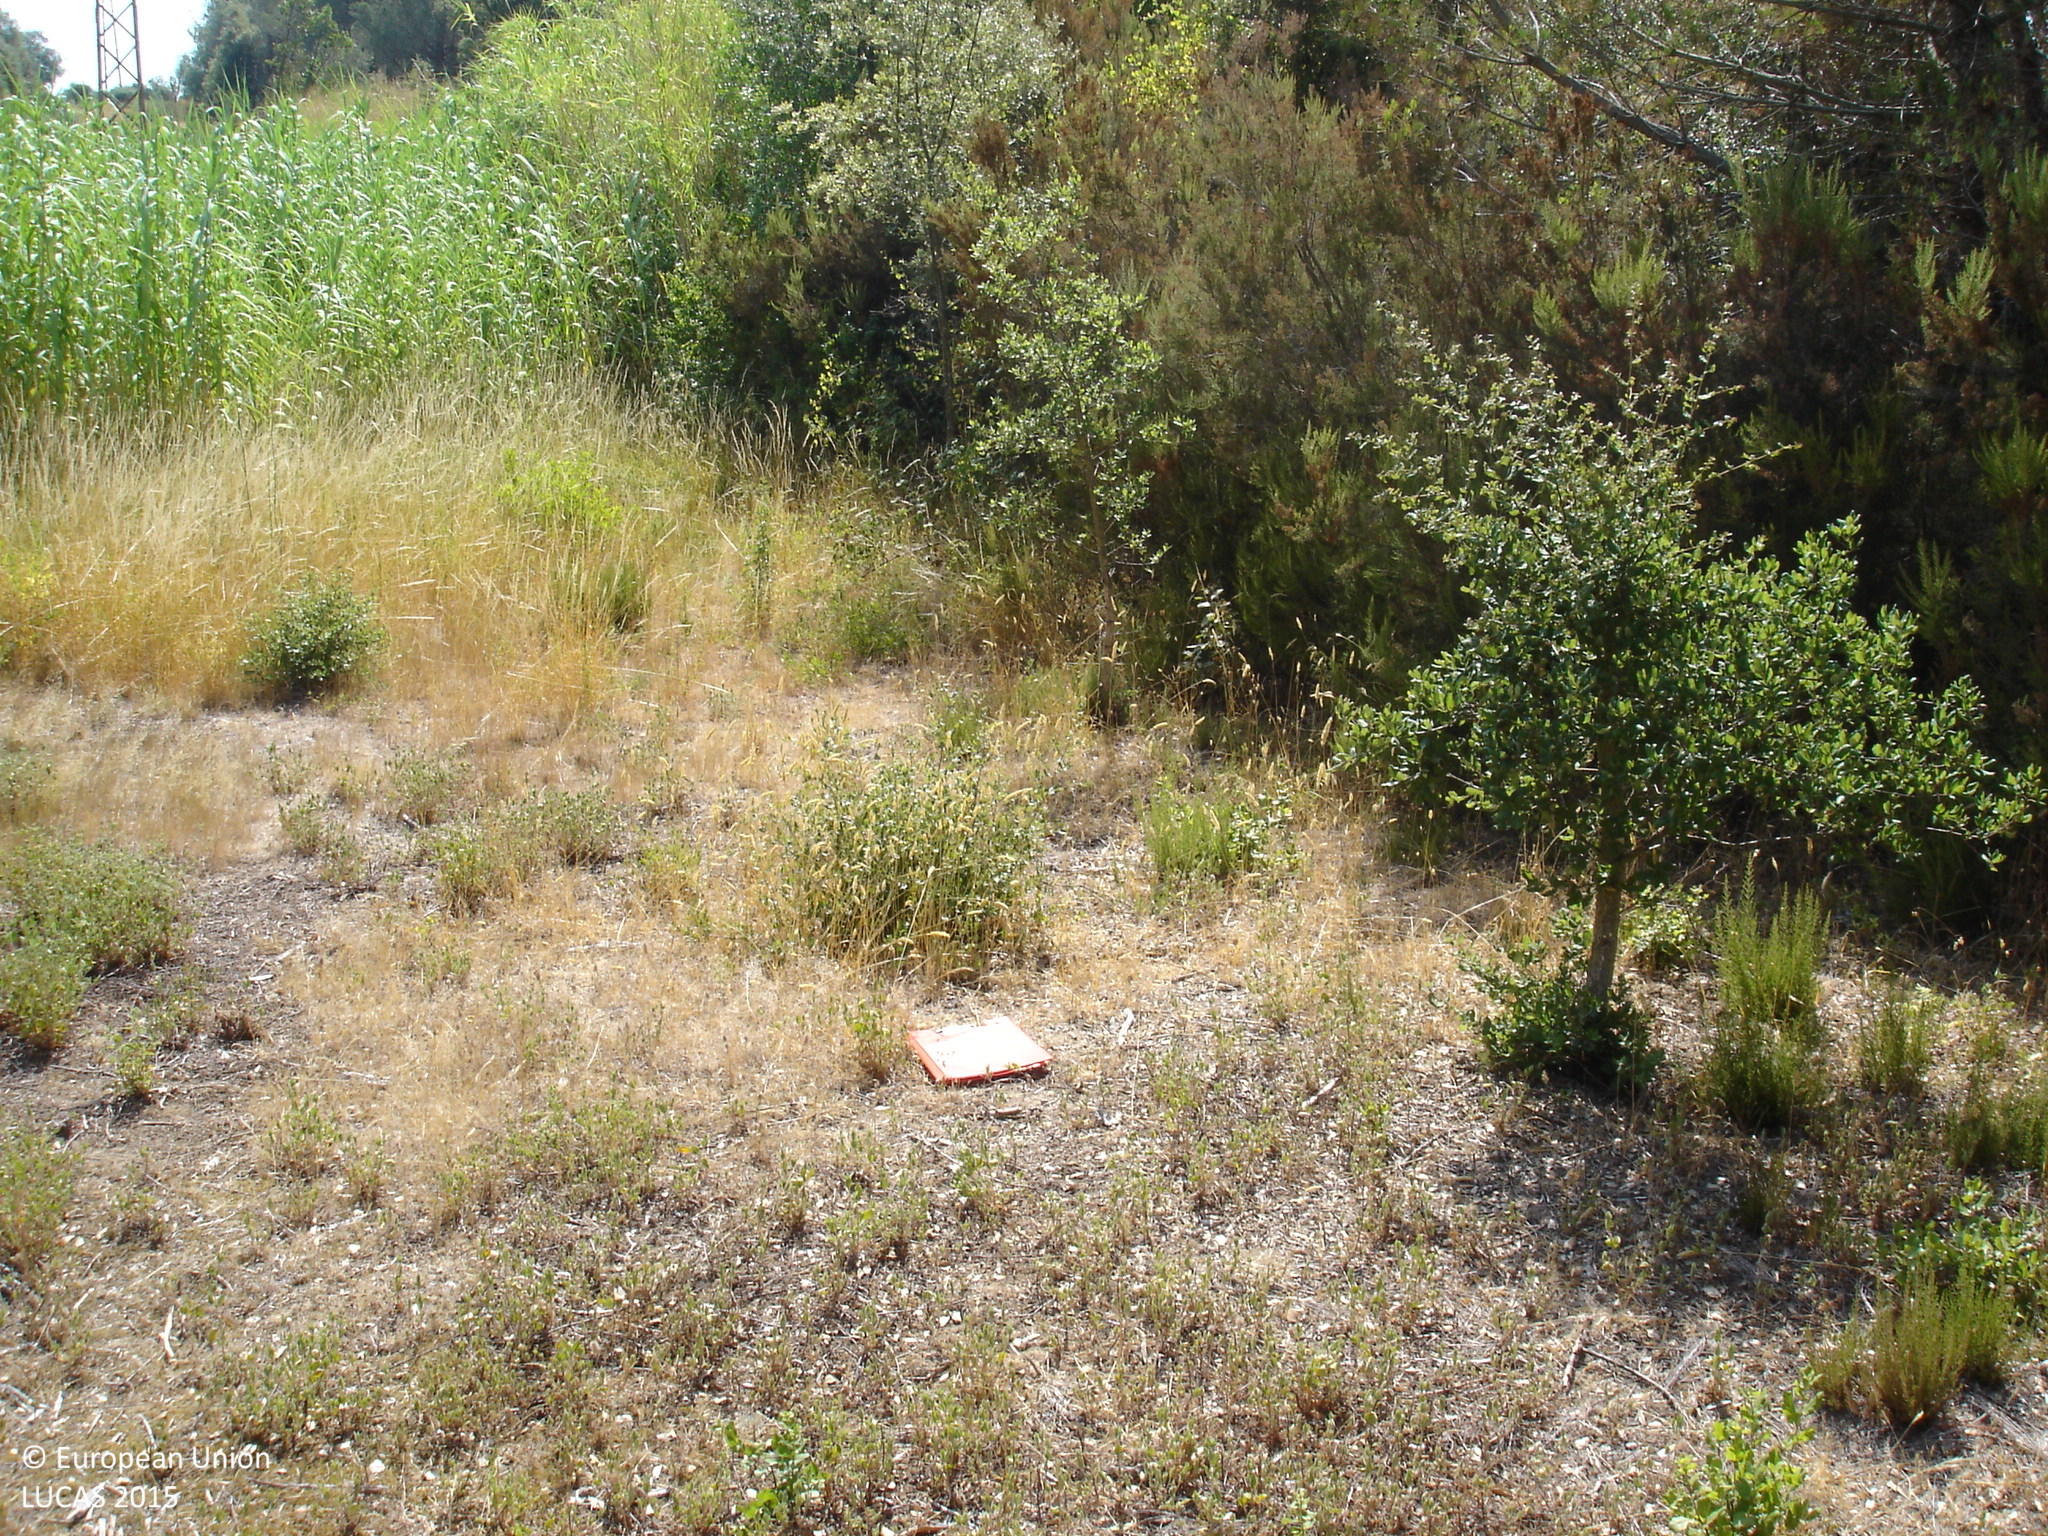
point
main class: Woodland
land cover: Other mixed woodland
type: thermophilous deciduous forest
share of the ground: 25 - 50 %
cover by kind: herbaceous plants 55 %, broadleaved forest trees 30 %, coniferous forest trees 15 %
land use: Forestry
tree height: > 5 m
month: July
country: ES
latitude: 41.8167
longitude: 3.0465
